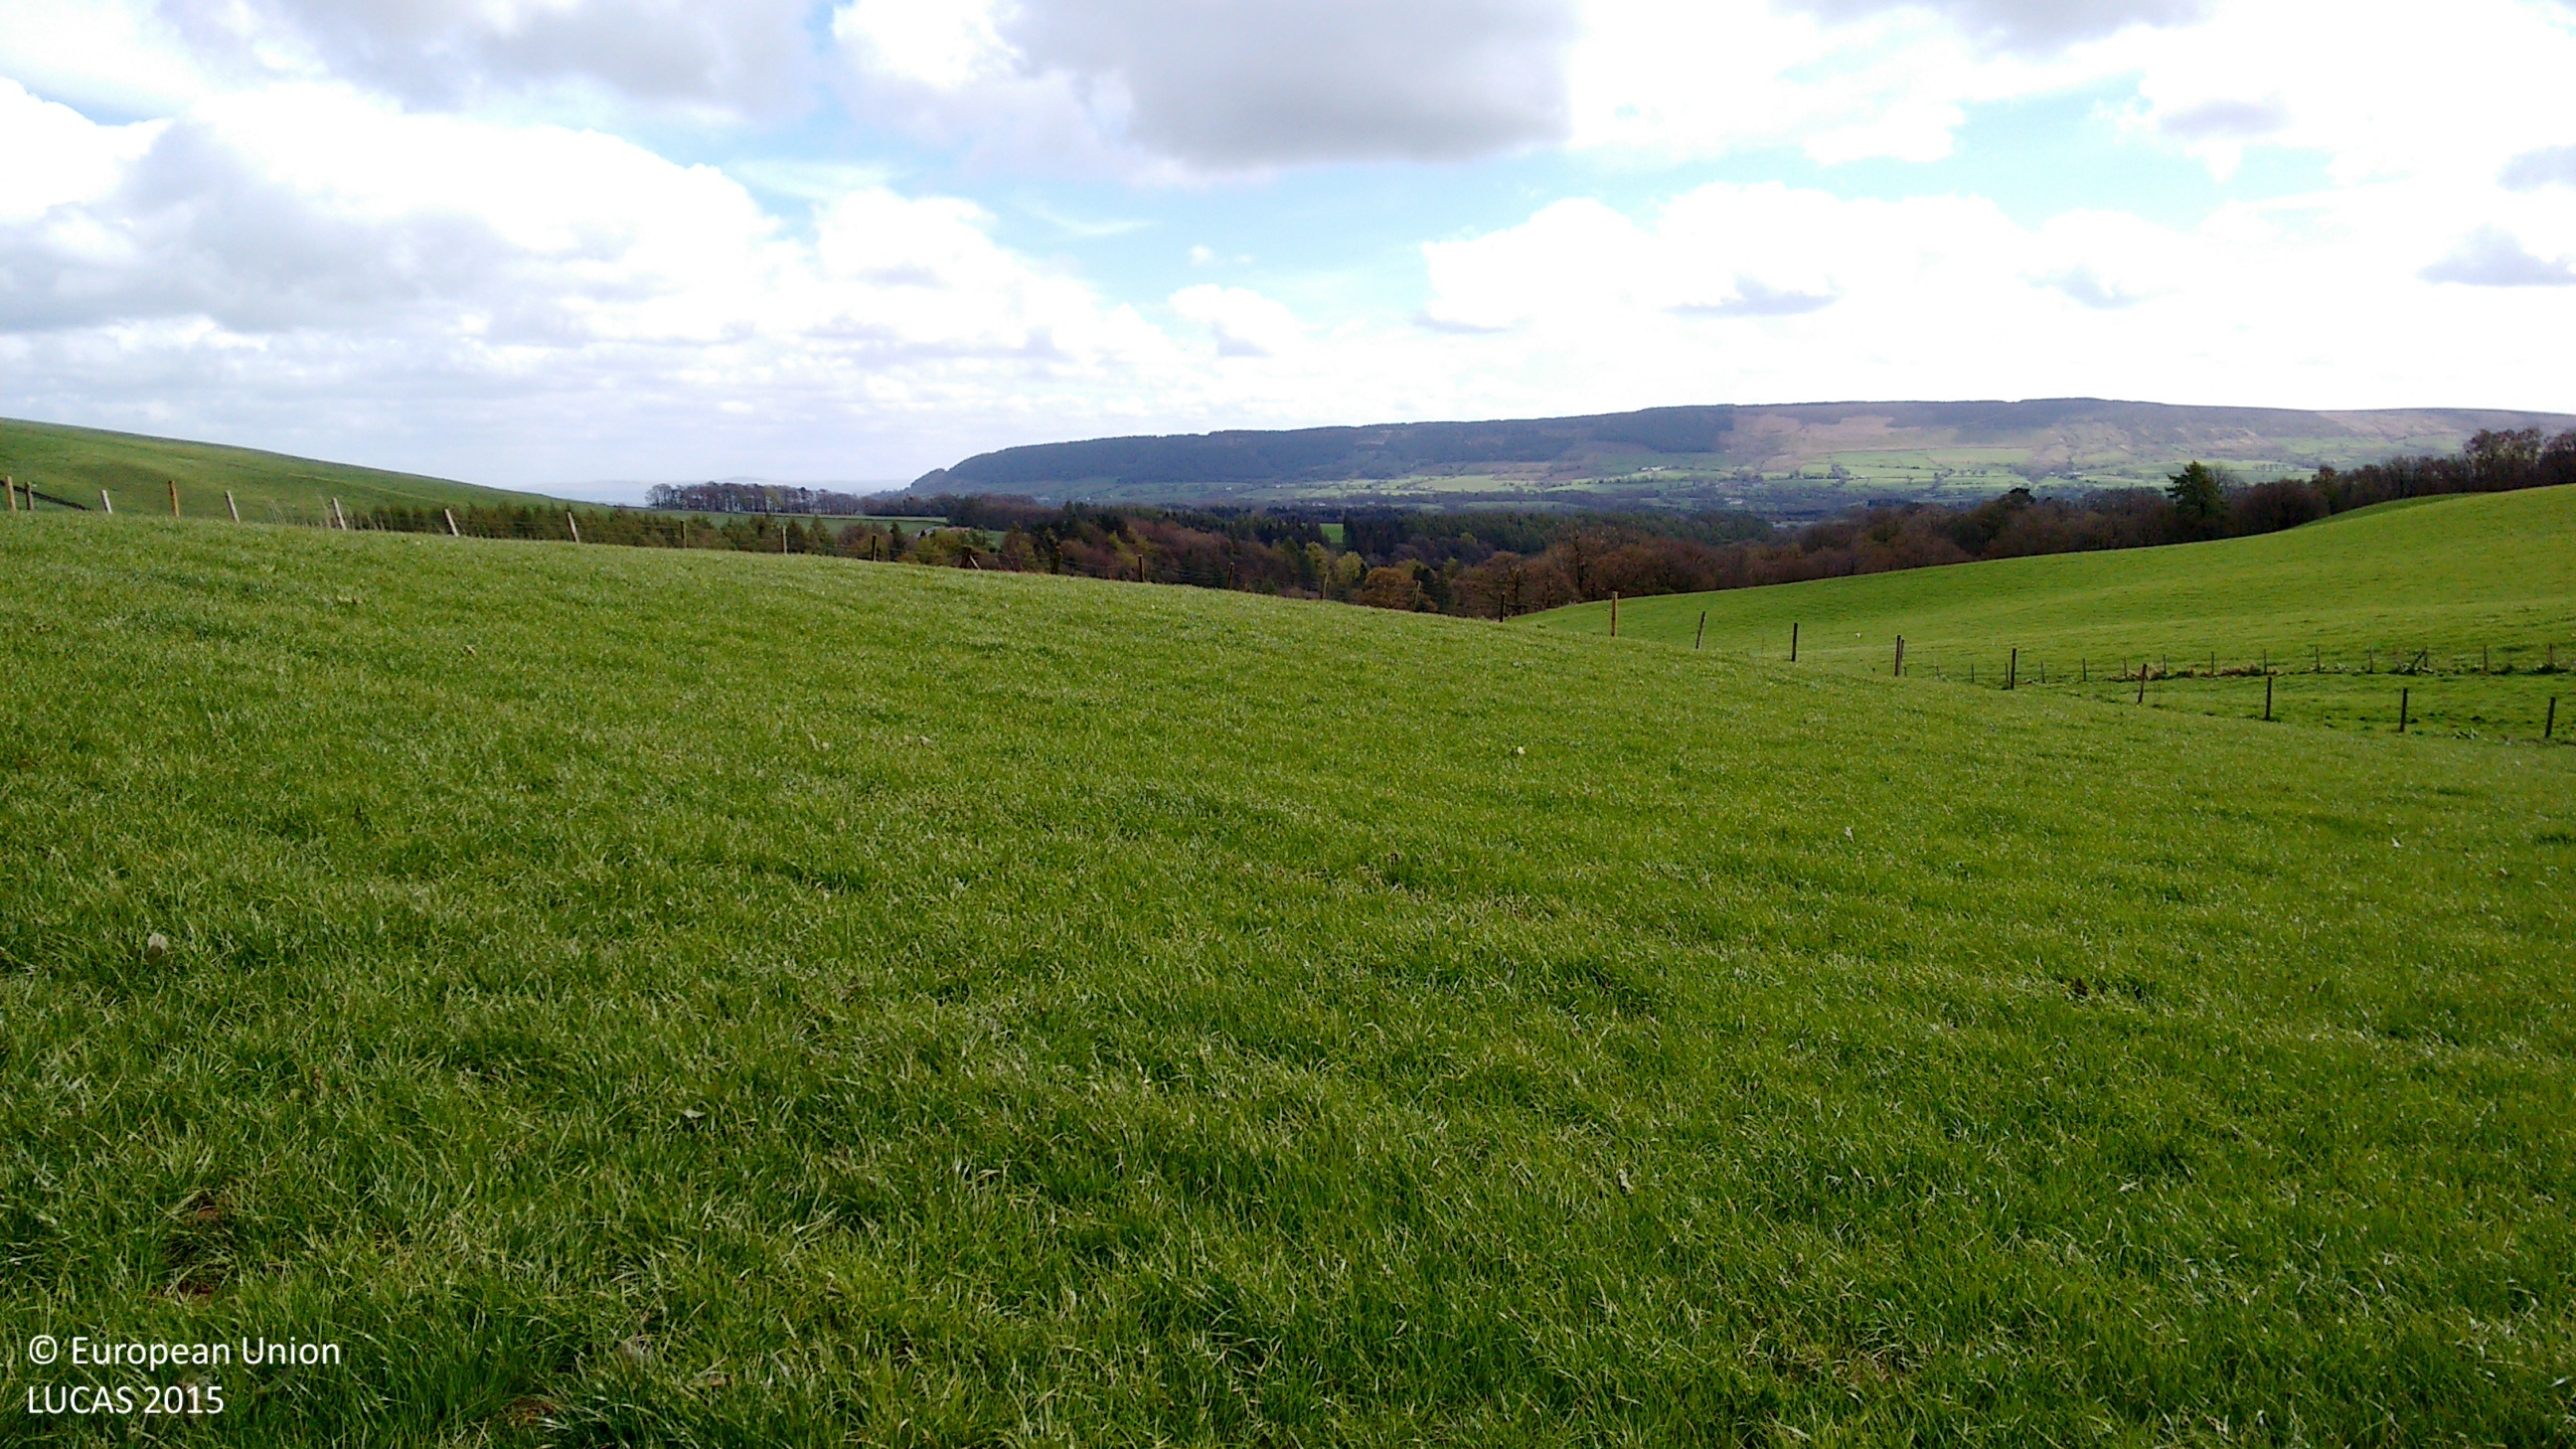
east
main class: Grassland
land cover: Grassland without tree/shrub cover
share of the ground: > 75 %
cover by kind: herbaceous plants 100 %
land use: Agriculture (excluding fallow land and kitchen gardens)
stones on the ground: < 10 %
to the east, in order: Grassland without tree/shrub cover; Fences; Grassland without tree/shrub cover; Fences; Broadleaved woodland
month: April
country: GB
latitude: 53.9127
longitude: -2.5337
